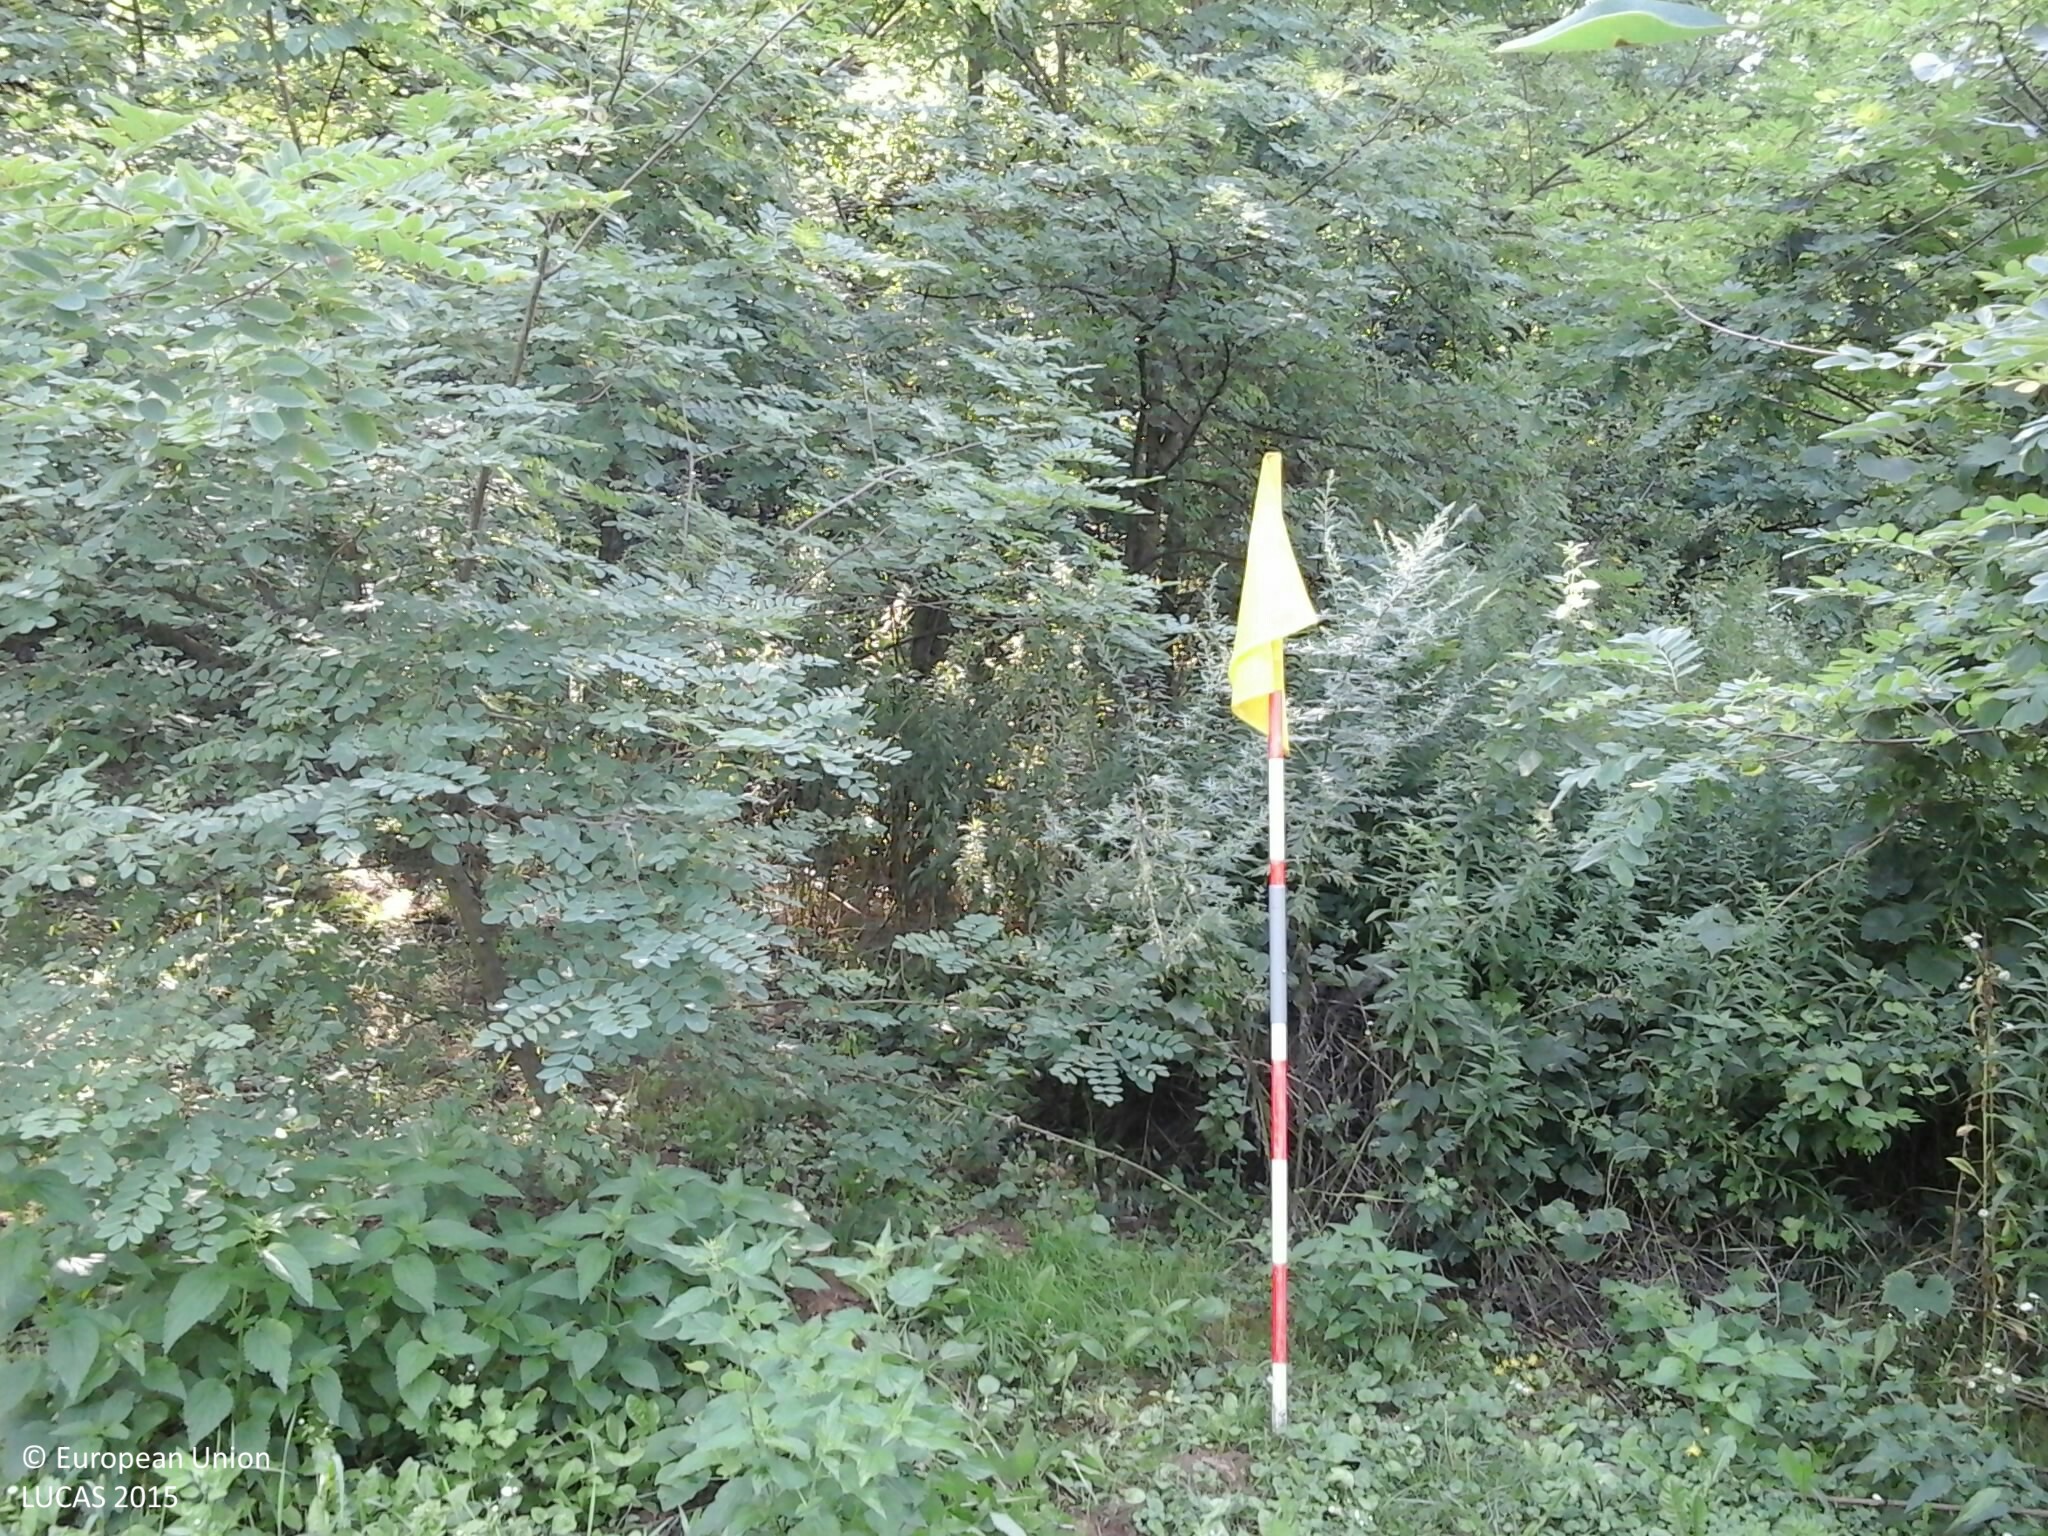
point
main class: Shrubland
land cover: Shrubland with sparse tree cover
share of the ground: > 75 %
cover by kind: herbaceous plants 75 %, shrubs 20 %, broadleaved forest trees 5 %
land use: Agriculture (excluding fallow land and kitchen gardens)
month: August
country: HU
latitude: 48.3028
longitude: 20.6731
